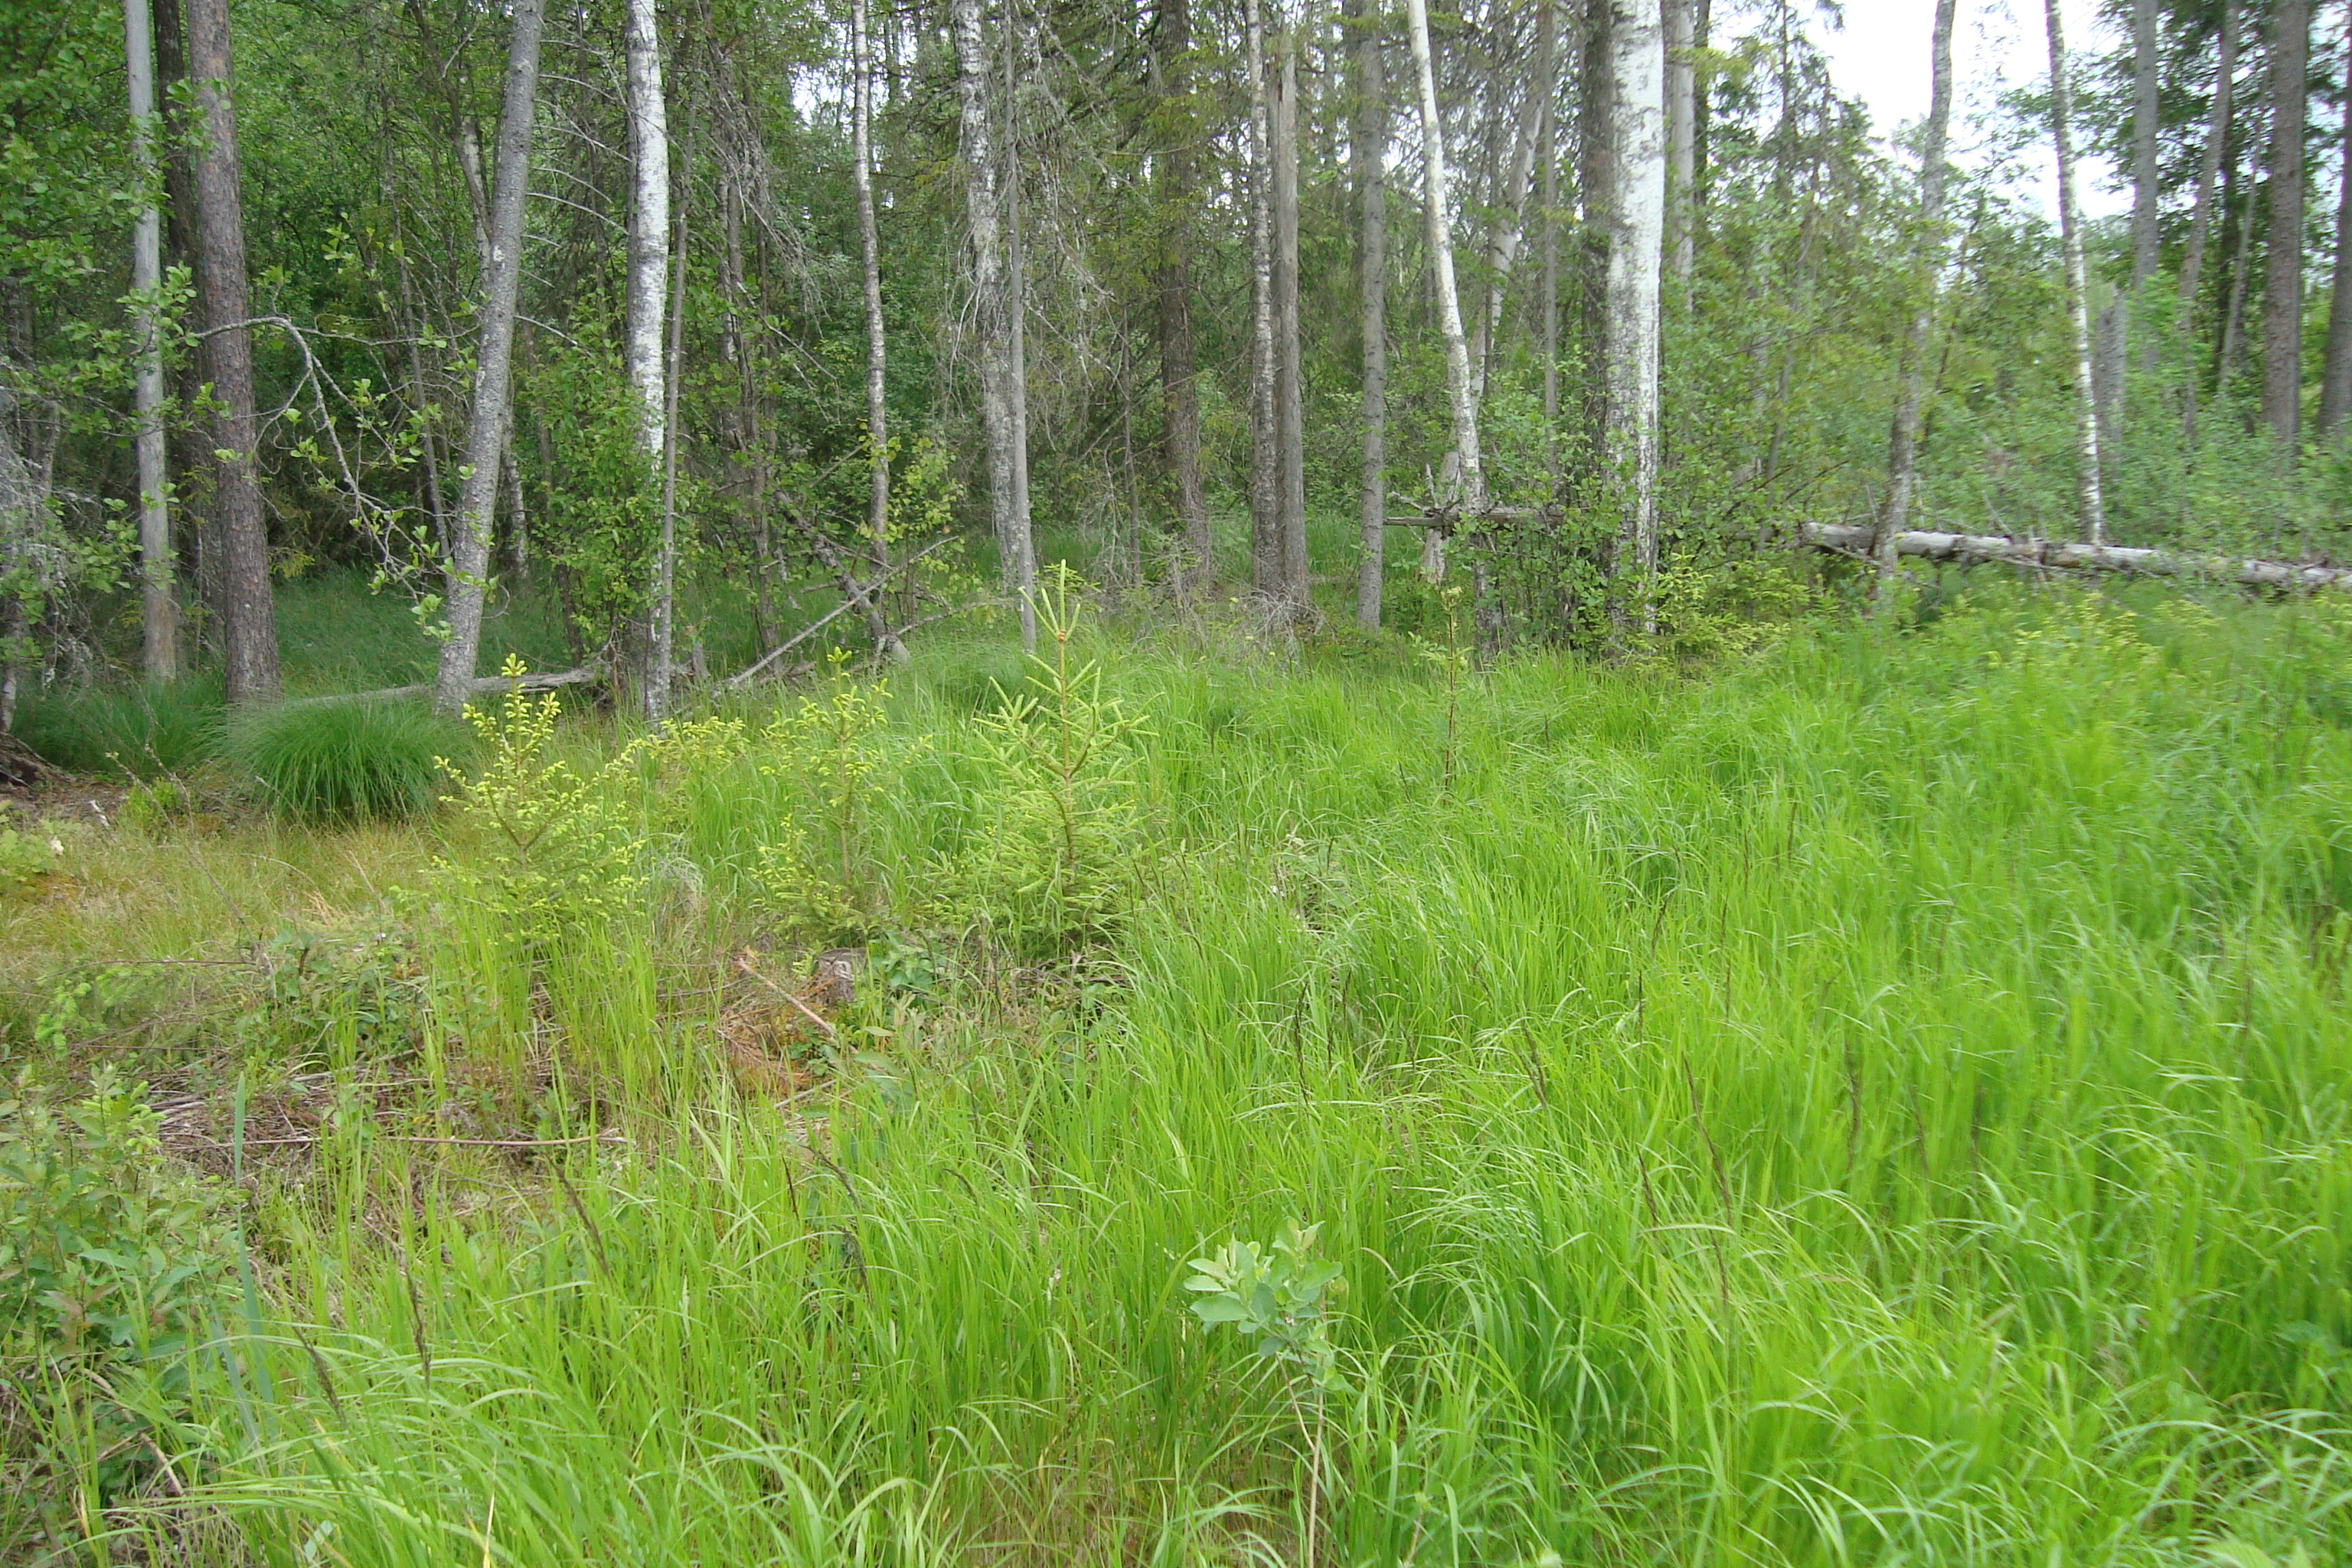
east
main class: Grassland
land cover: Grassland with sparse tree/shrub cover
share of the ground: > 75 %
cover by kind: herbaceous plants 85 %, coniferous forest trees 5 %, shrubs 5 %
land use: Forestry
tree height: < 5 m
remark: Clear cut
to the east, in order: Grassland with sparse tree/shrub cover; Broadleaved woodland; Other mixed woodland; Other bare soil; Pine dominated coniferous woodland; Other bare soil; Spruce dominated mixed woodland
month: June
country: LV
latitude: 57.1771
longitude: 26.2995
